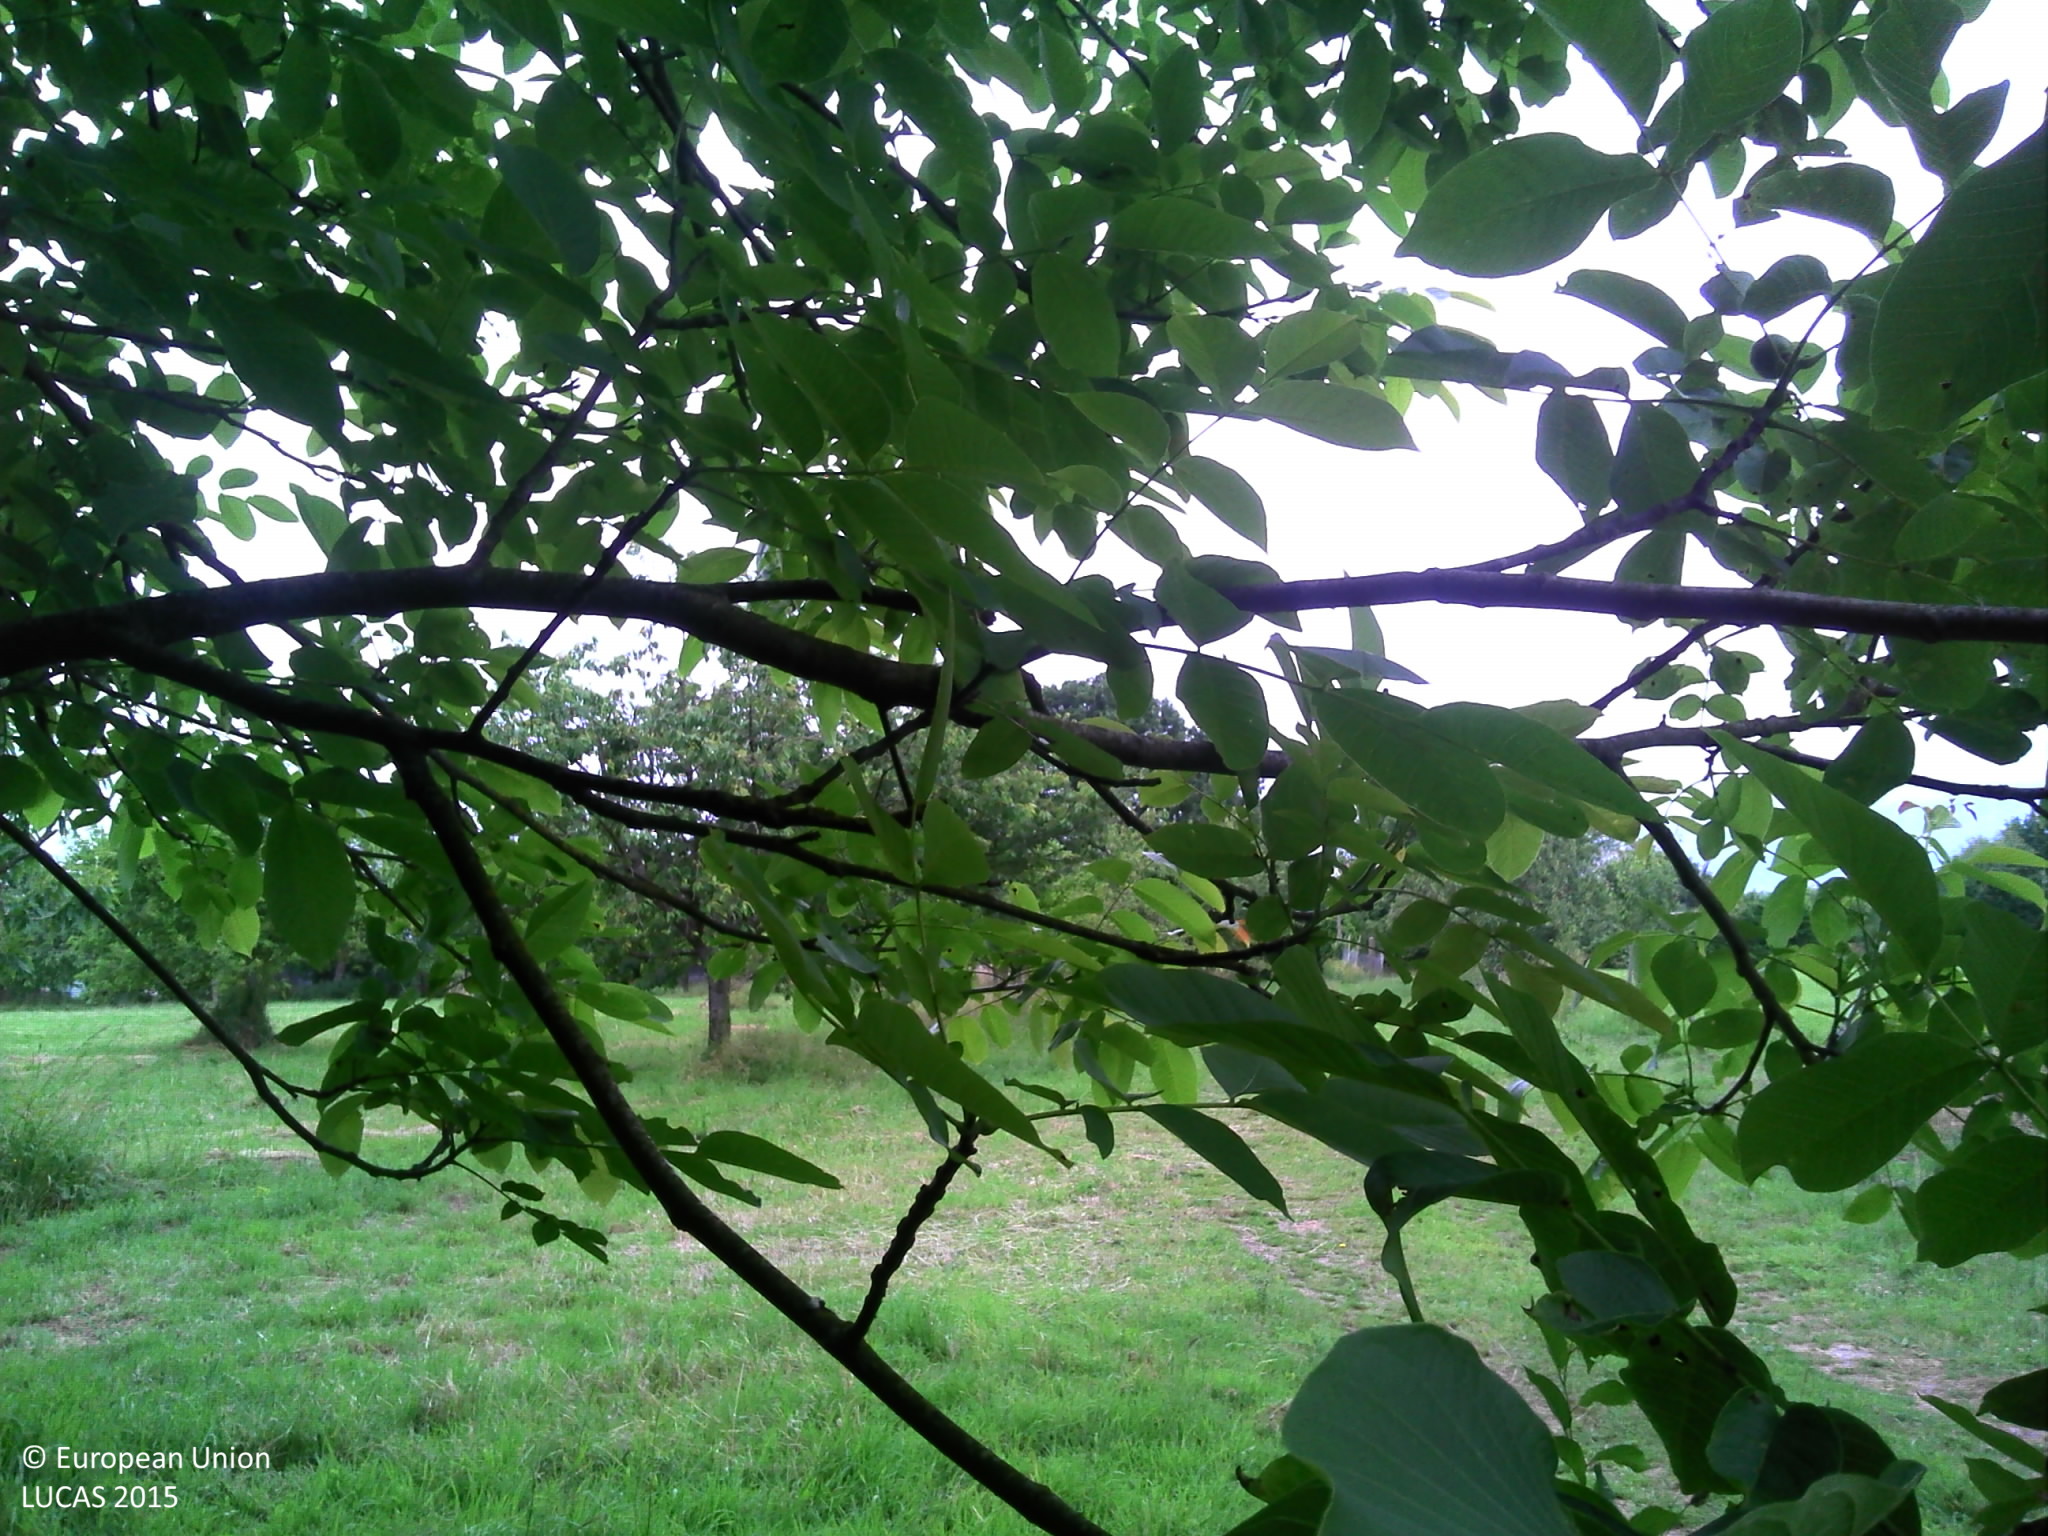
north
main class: Grassland
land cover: Grassland with sparse tree/shrub cover
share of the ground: > 75 %
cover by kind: herbaceous plants 95 %, broadleaved forest trees 5 %
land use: Agriculture (excluding fallow land and kitchen gardens)
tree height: > 5 m
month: June
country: FR
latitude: 48.0417
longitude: 0.2225
